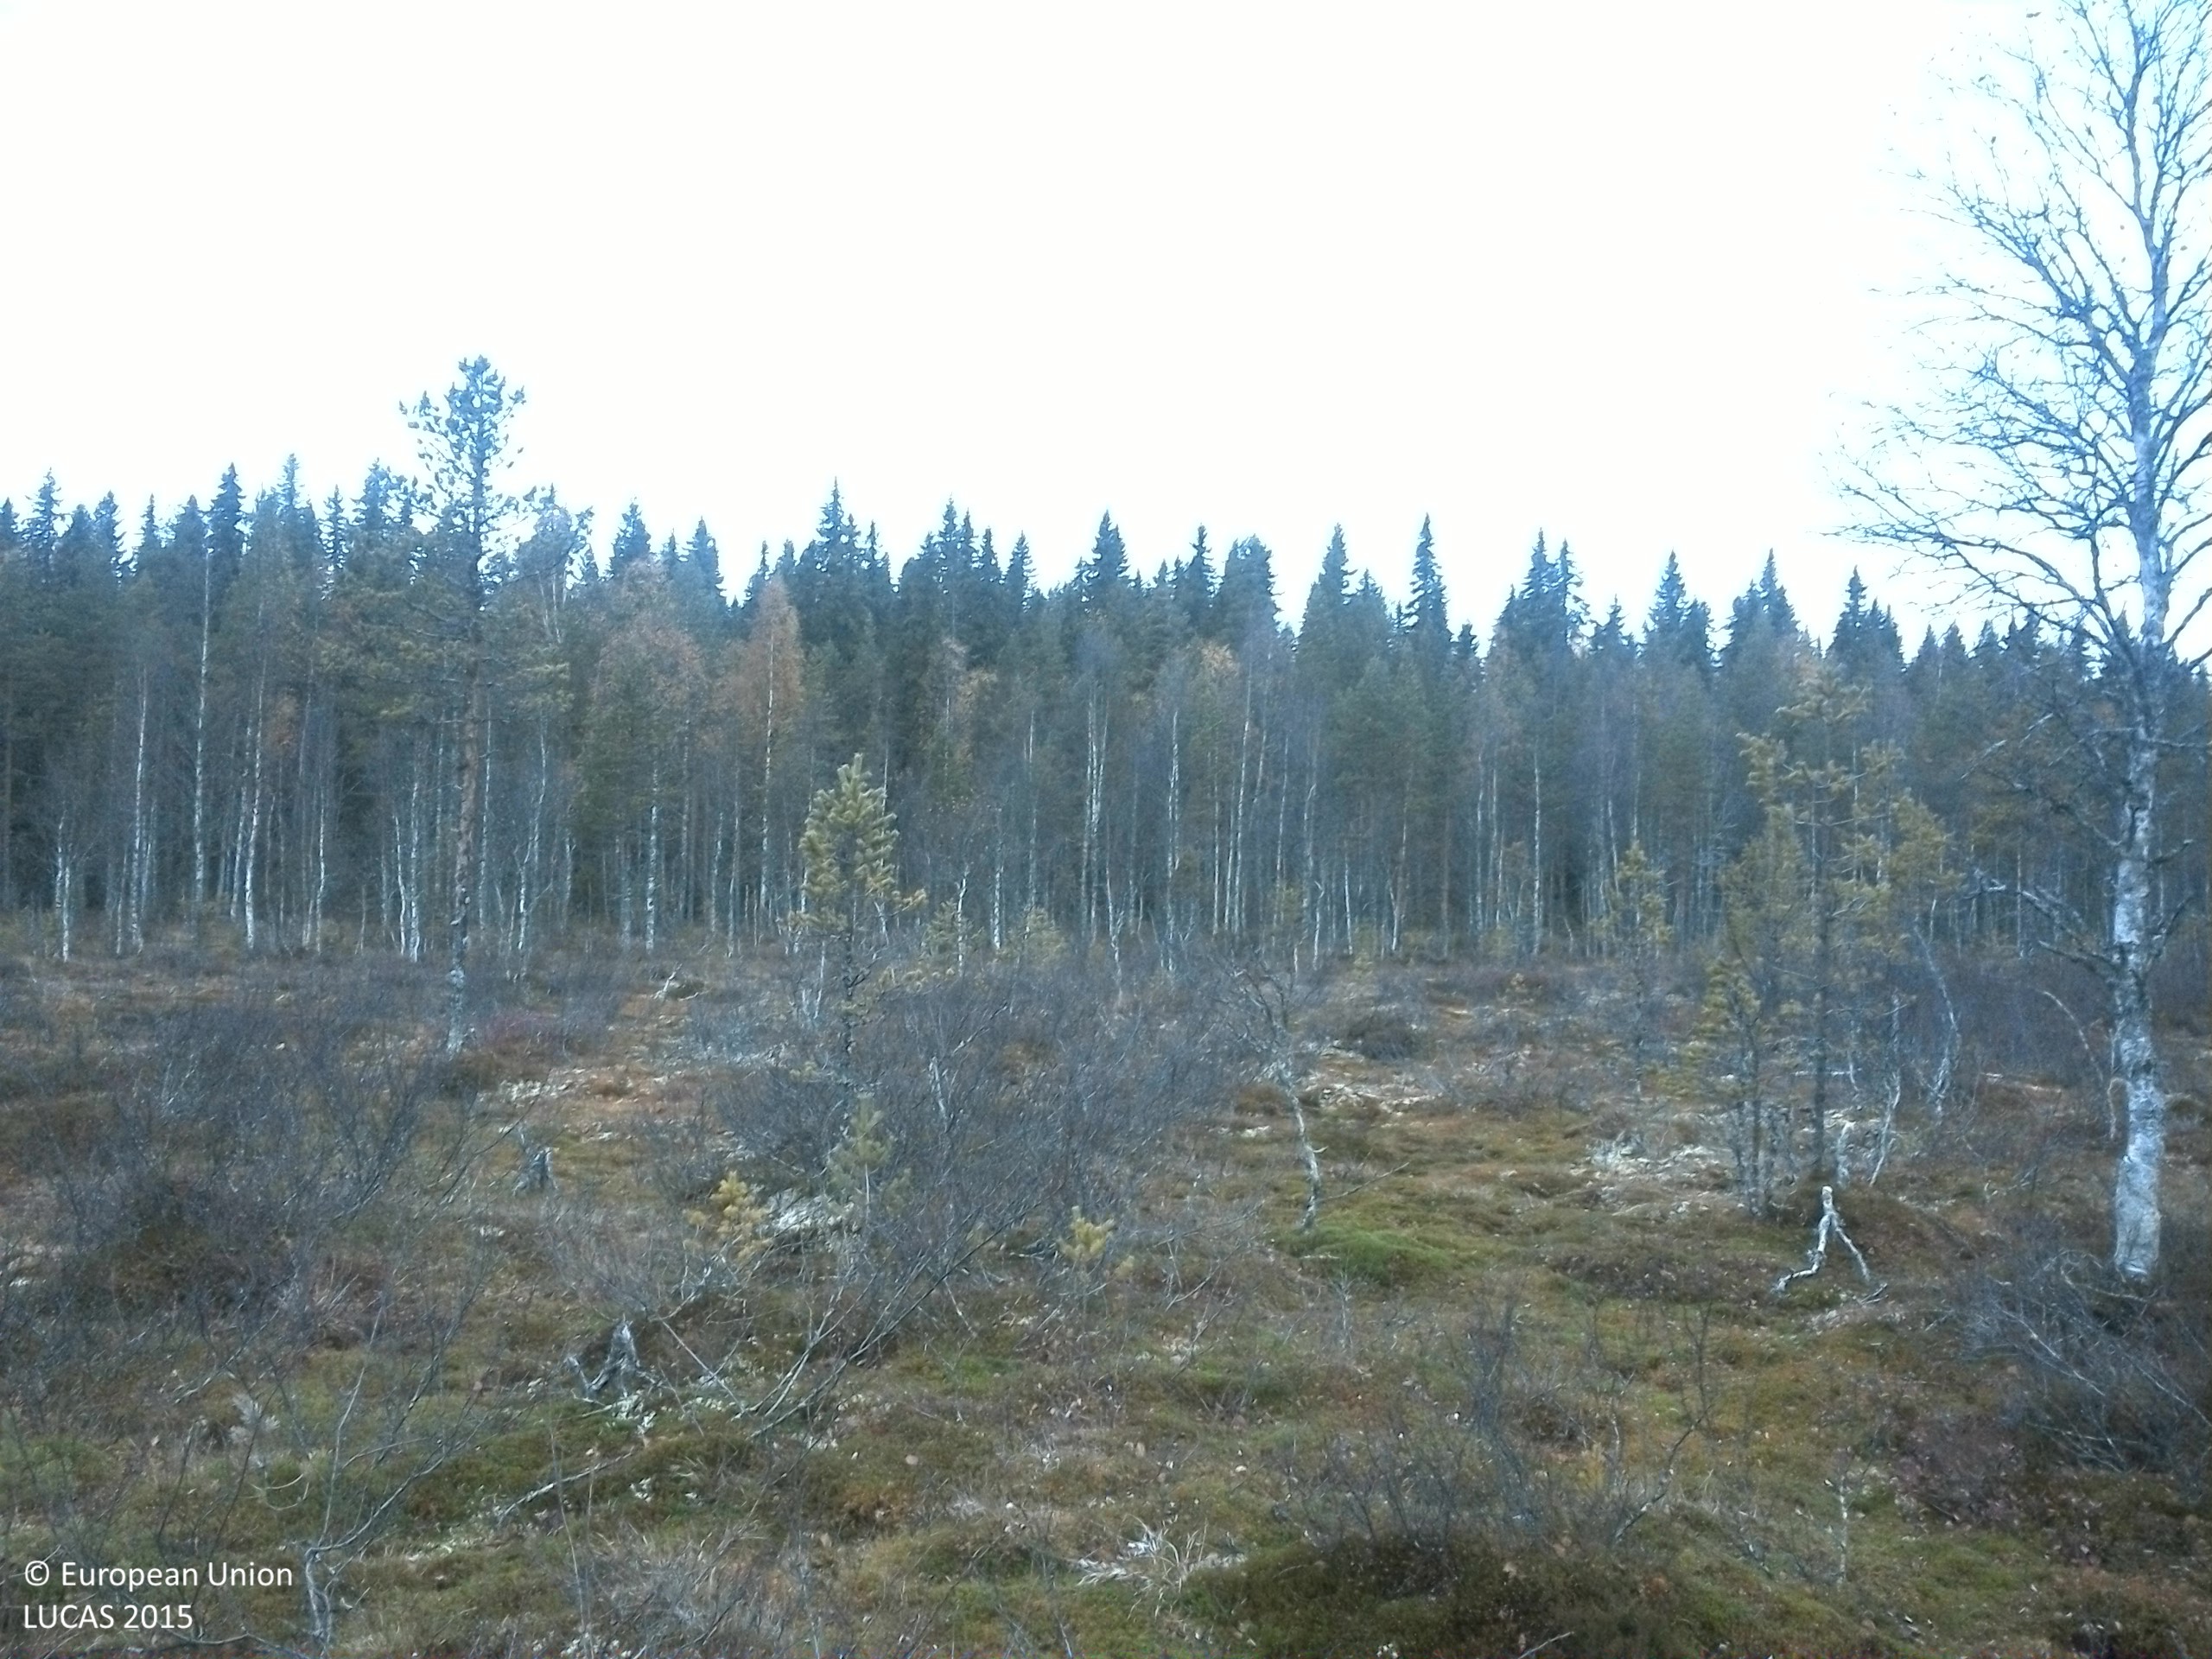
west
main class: Woodland
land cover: Pine dominated mixed woodland
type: mire and swamp forests
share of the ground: 10 - 25 %
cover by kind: shrubs 30 %, herbaceous plants 30 %, lichens and mosses 30 %, coniferous forest trees 5 %, broadleaved forest trees 5 %
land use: Semi-natural and natural areas not in use
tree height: < 5 m
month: October
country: SE
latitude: 64.0667
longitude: 16.0171
